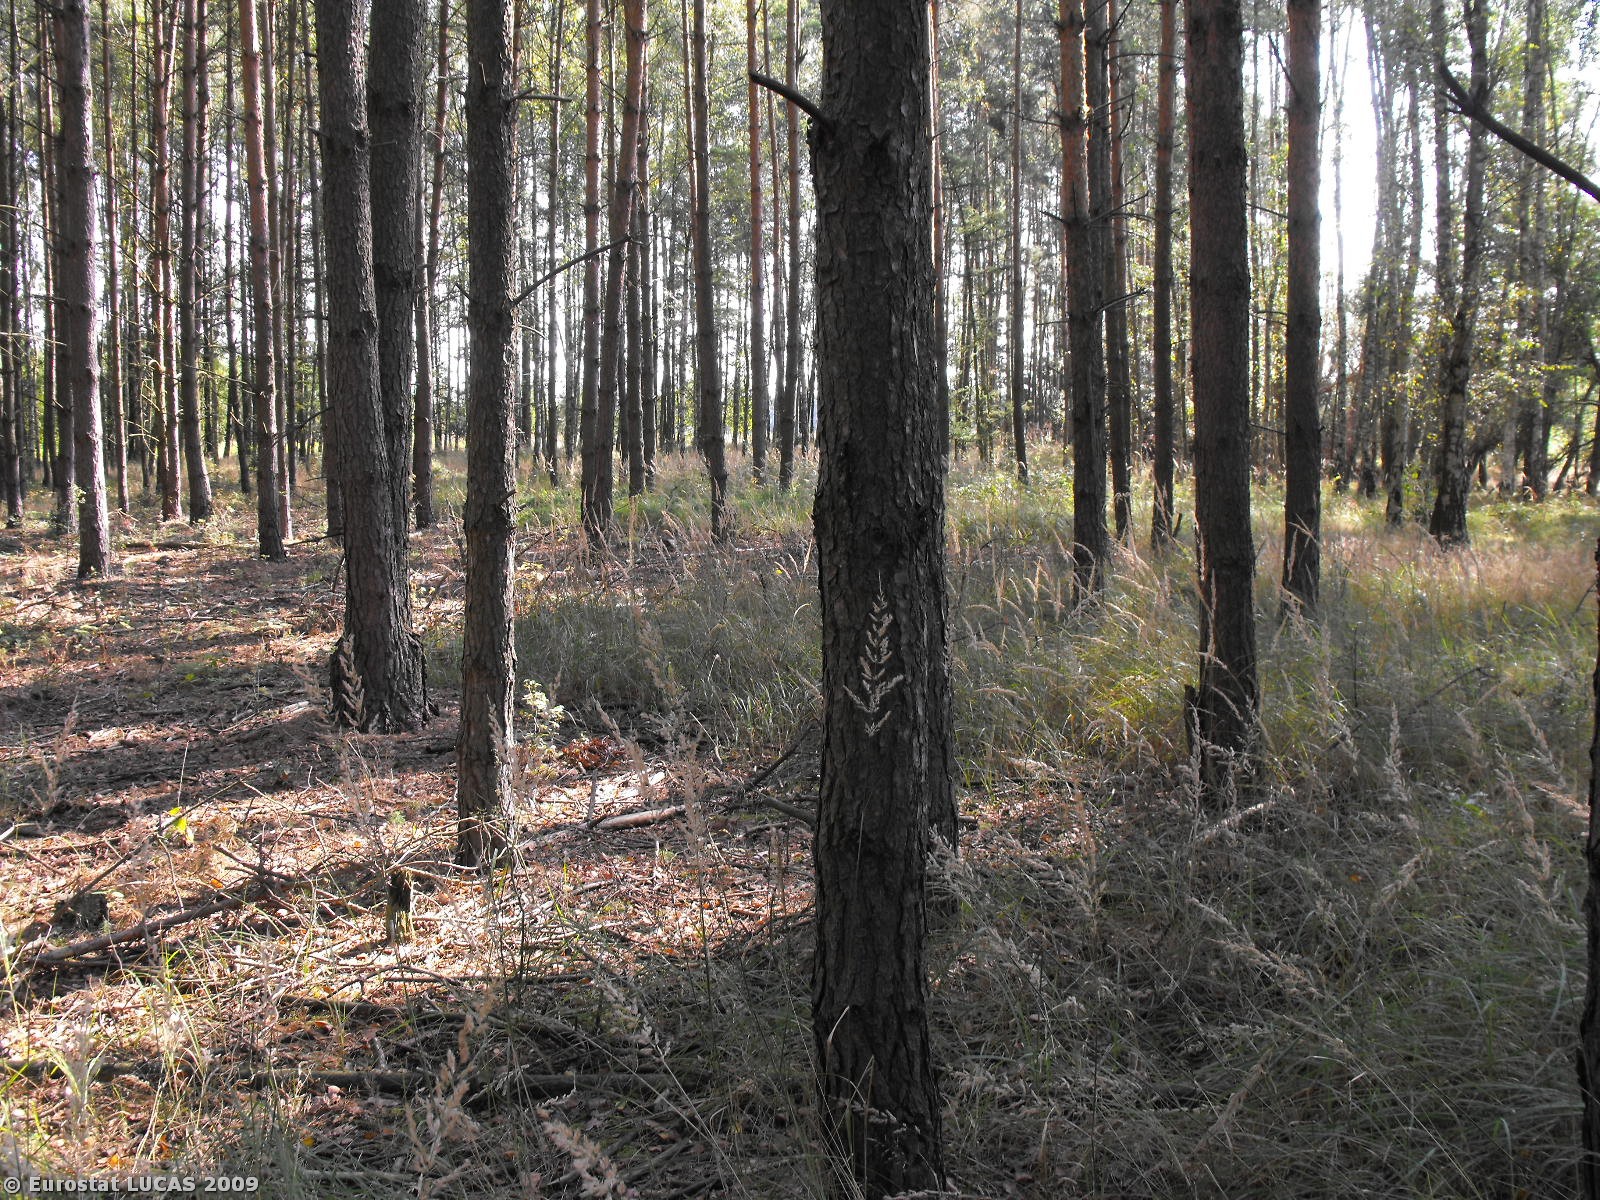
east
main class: Woodland
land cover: Coniferous woodland
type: hemiboreal forest and nemoral coniferous forest and mixed broadleaved-coniferous forest
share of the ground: > 75 %
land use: Forestry
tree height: > 5 m
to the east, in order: Coniferous woodland; Mixed woodland; Grass margins; Oats
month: September
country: PL
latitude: 52.3362
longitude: 16.3028
